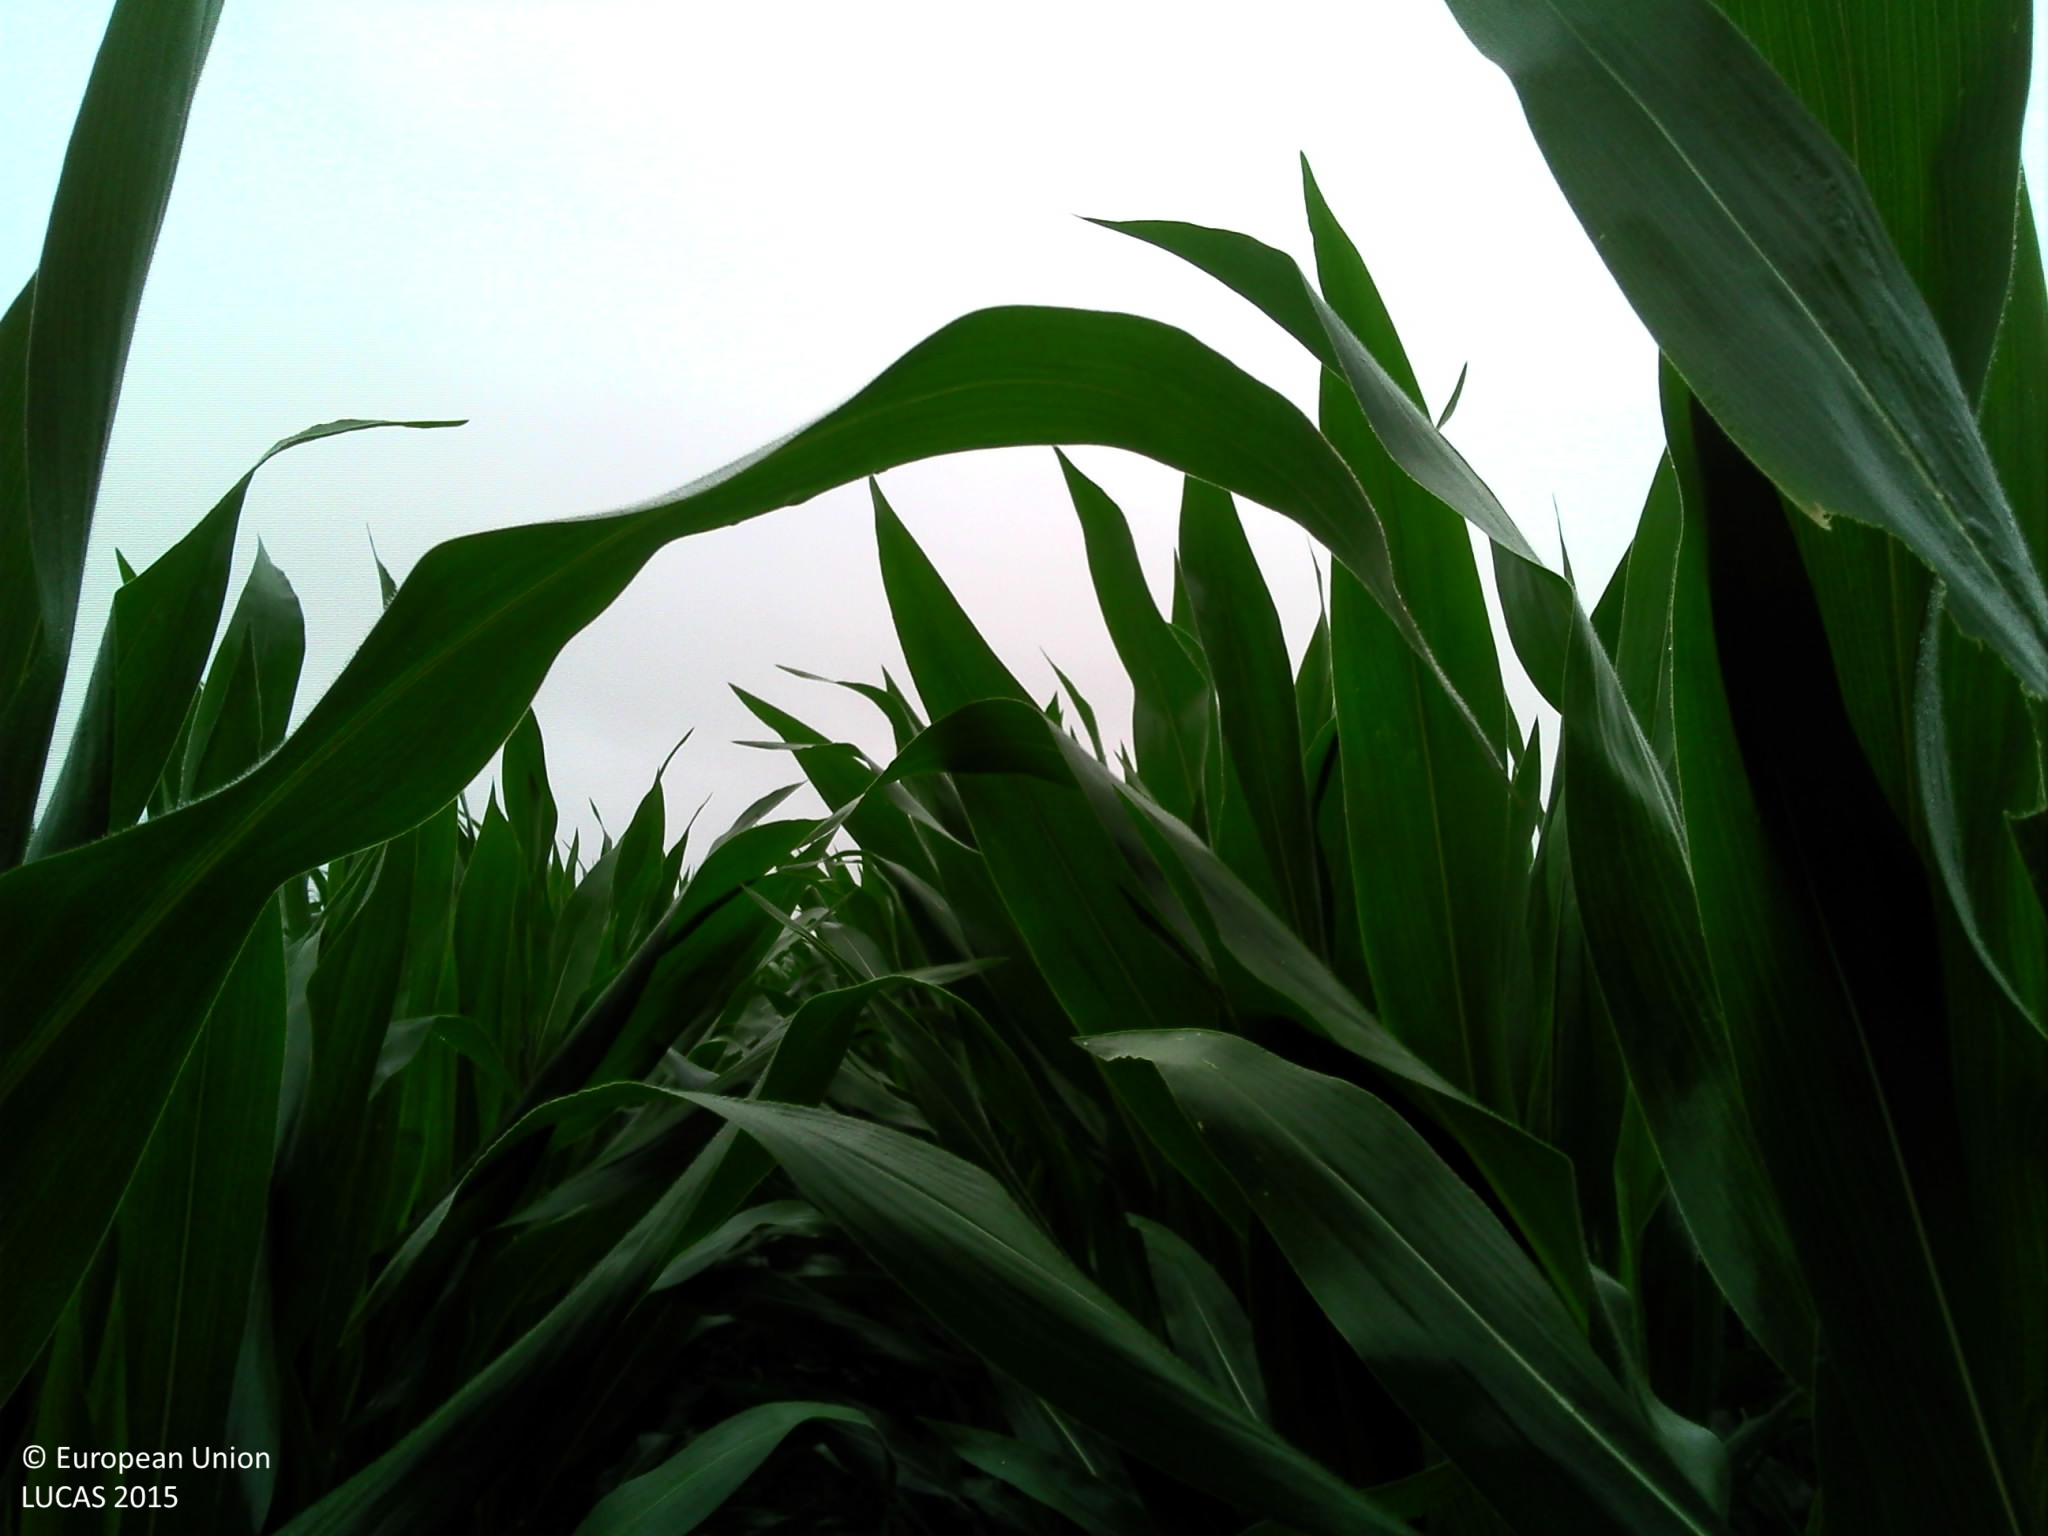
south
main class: Cropland
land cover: Maize
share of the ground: 50 - 75 %
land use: Agriculture (excluding fallow land and kitchen gardens)
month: July
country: FR
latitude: 48.2210
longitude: -2.3199
